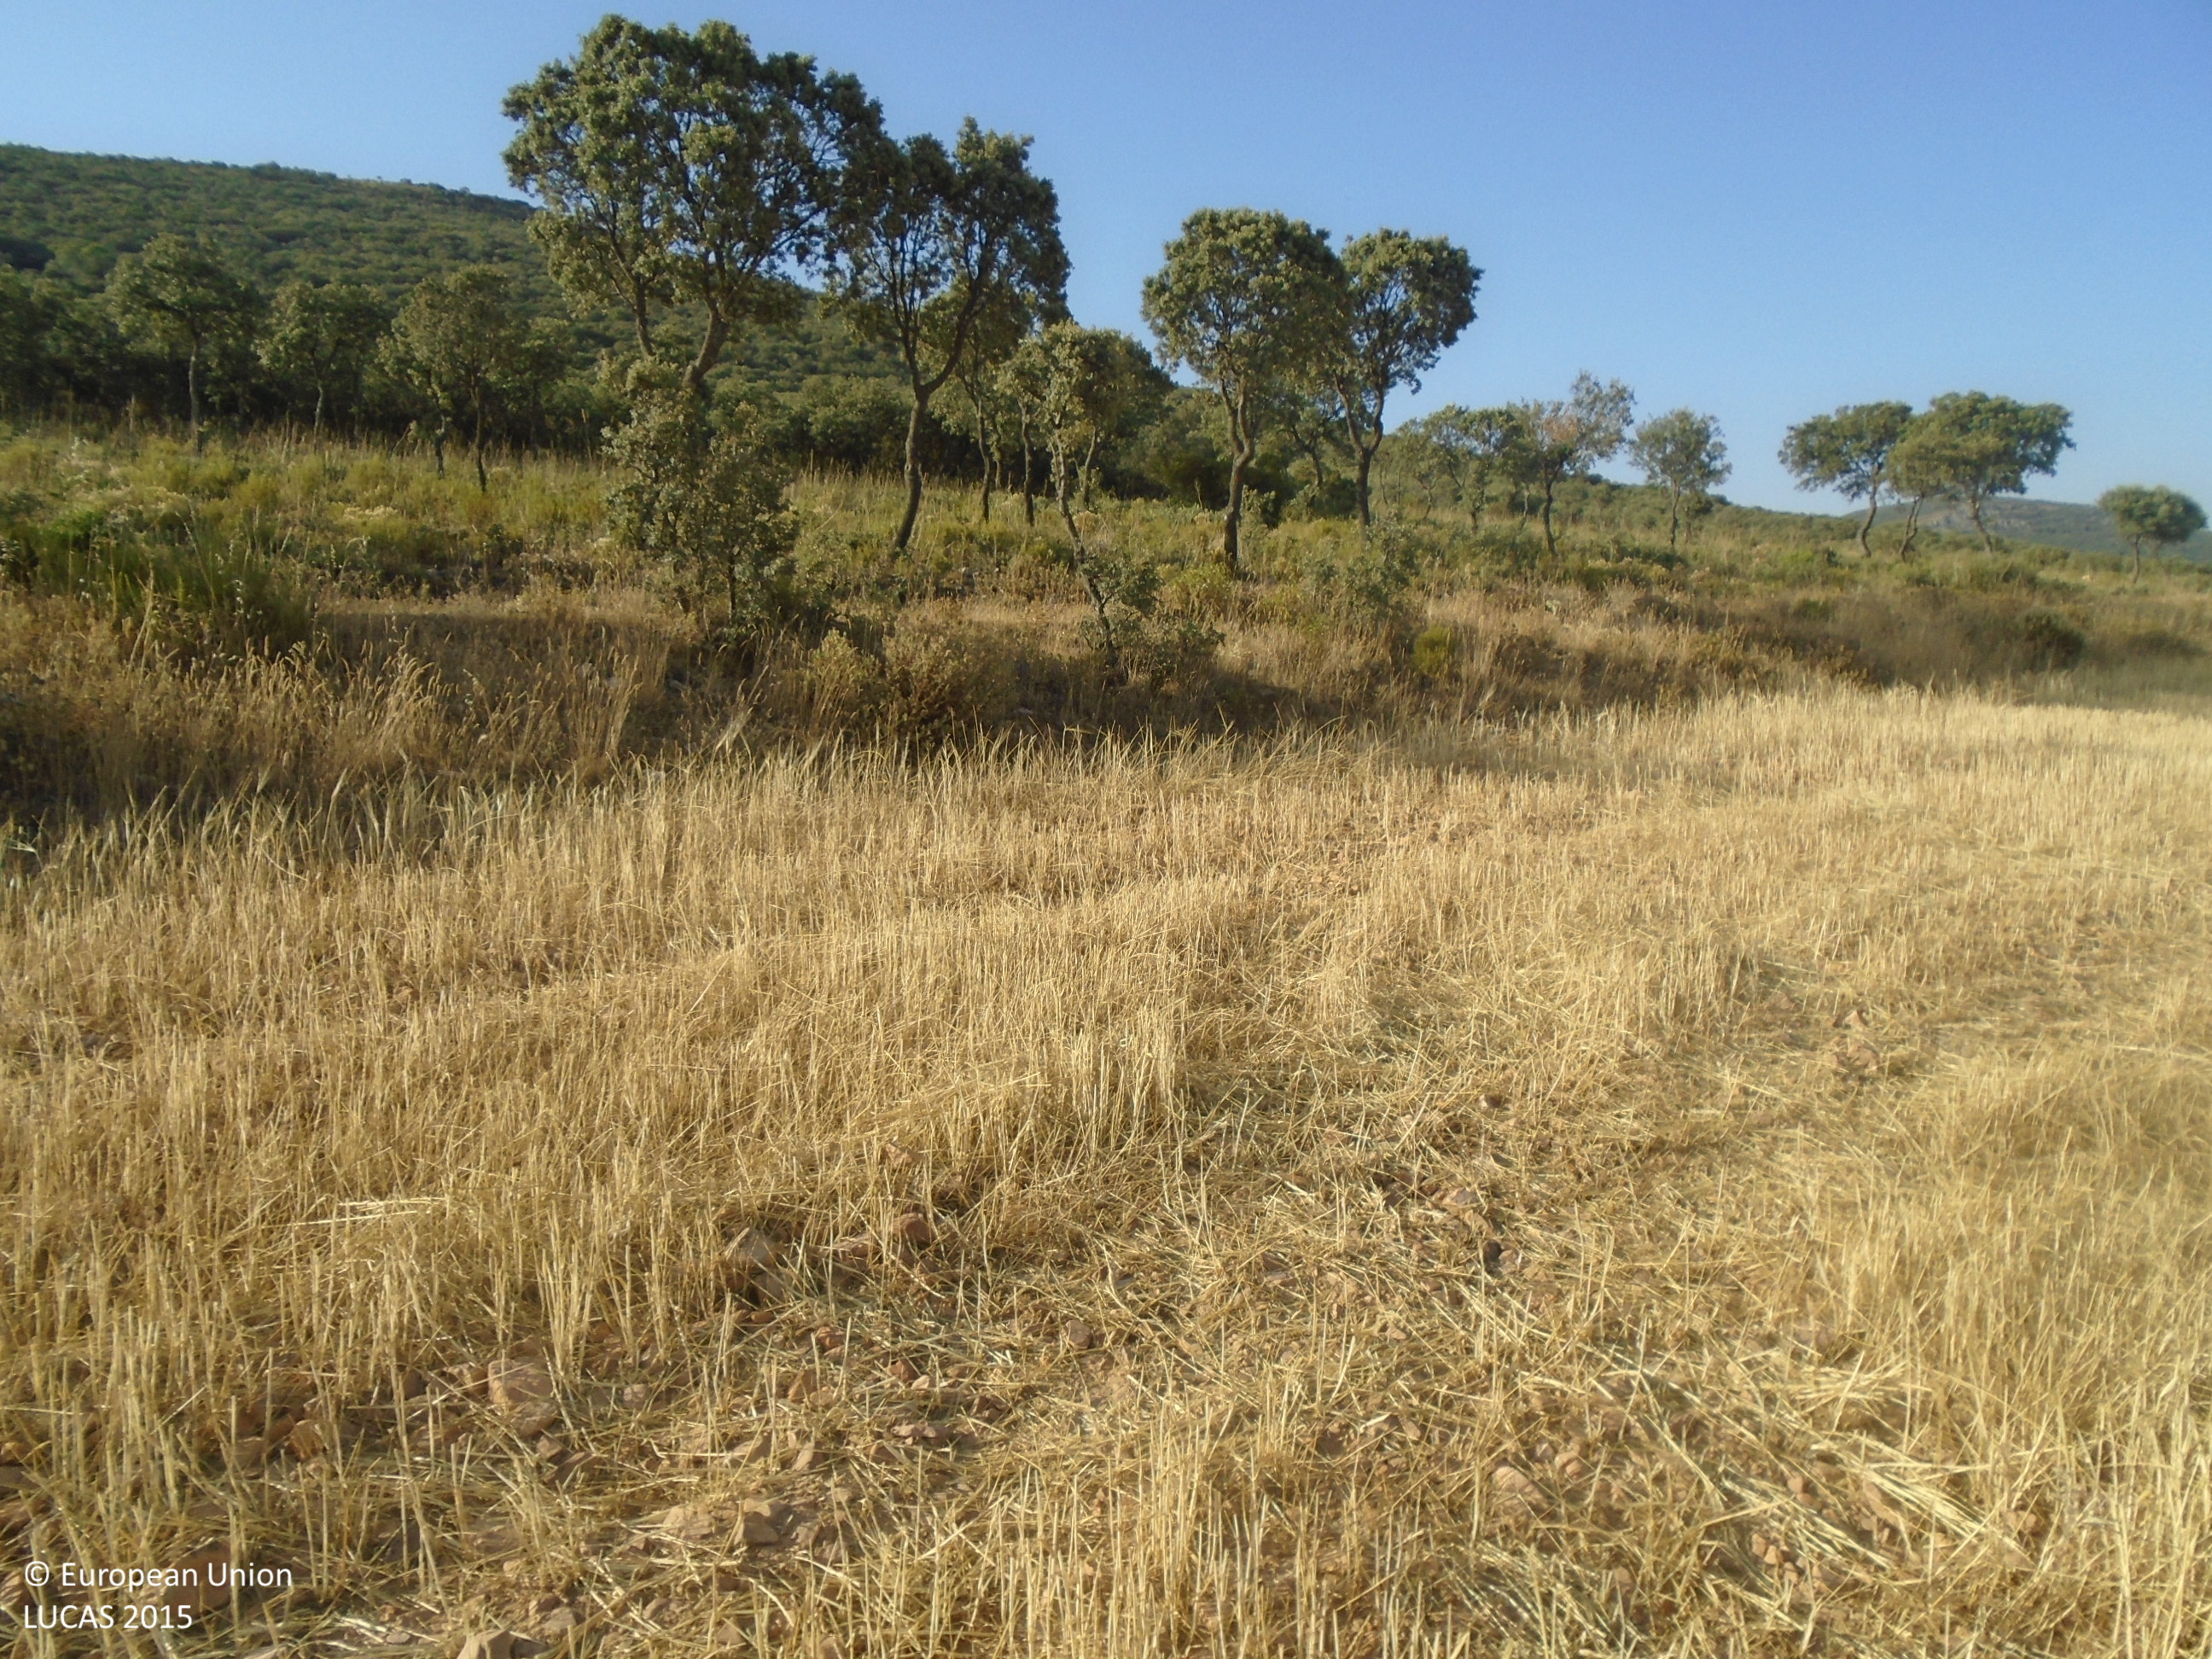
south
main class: Cropland
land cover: Barley
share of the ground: > 75 %
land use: Agriculture (excluding fallow land and kitchen gardens)
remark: Harvested field
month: July
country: ES
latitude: 39.3587
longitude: -3.6826
